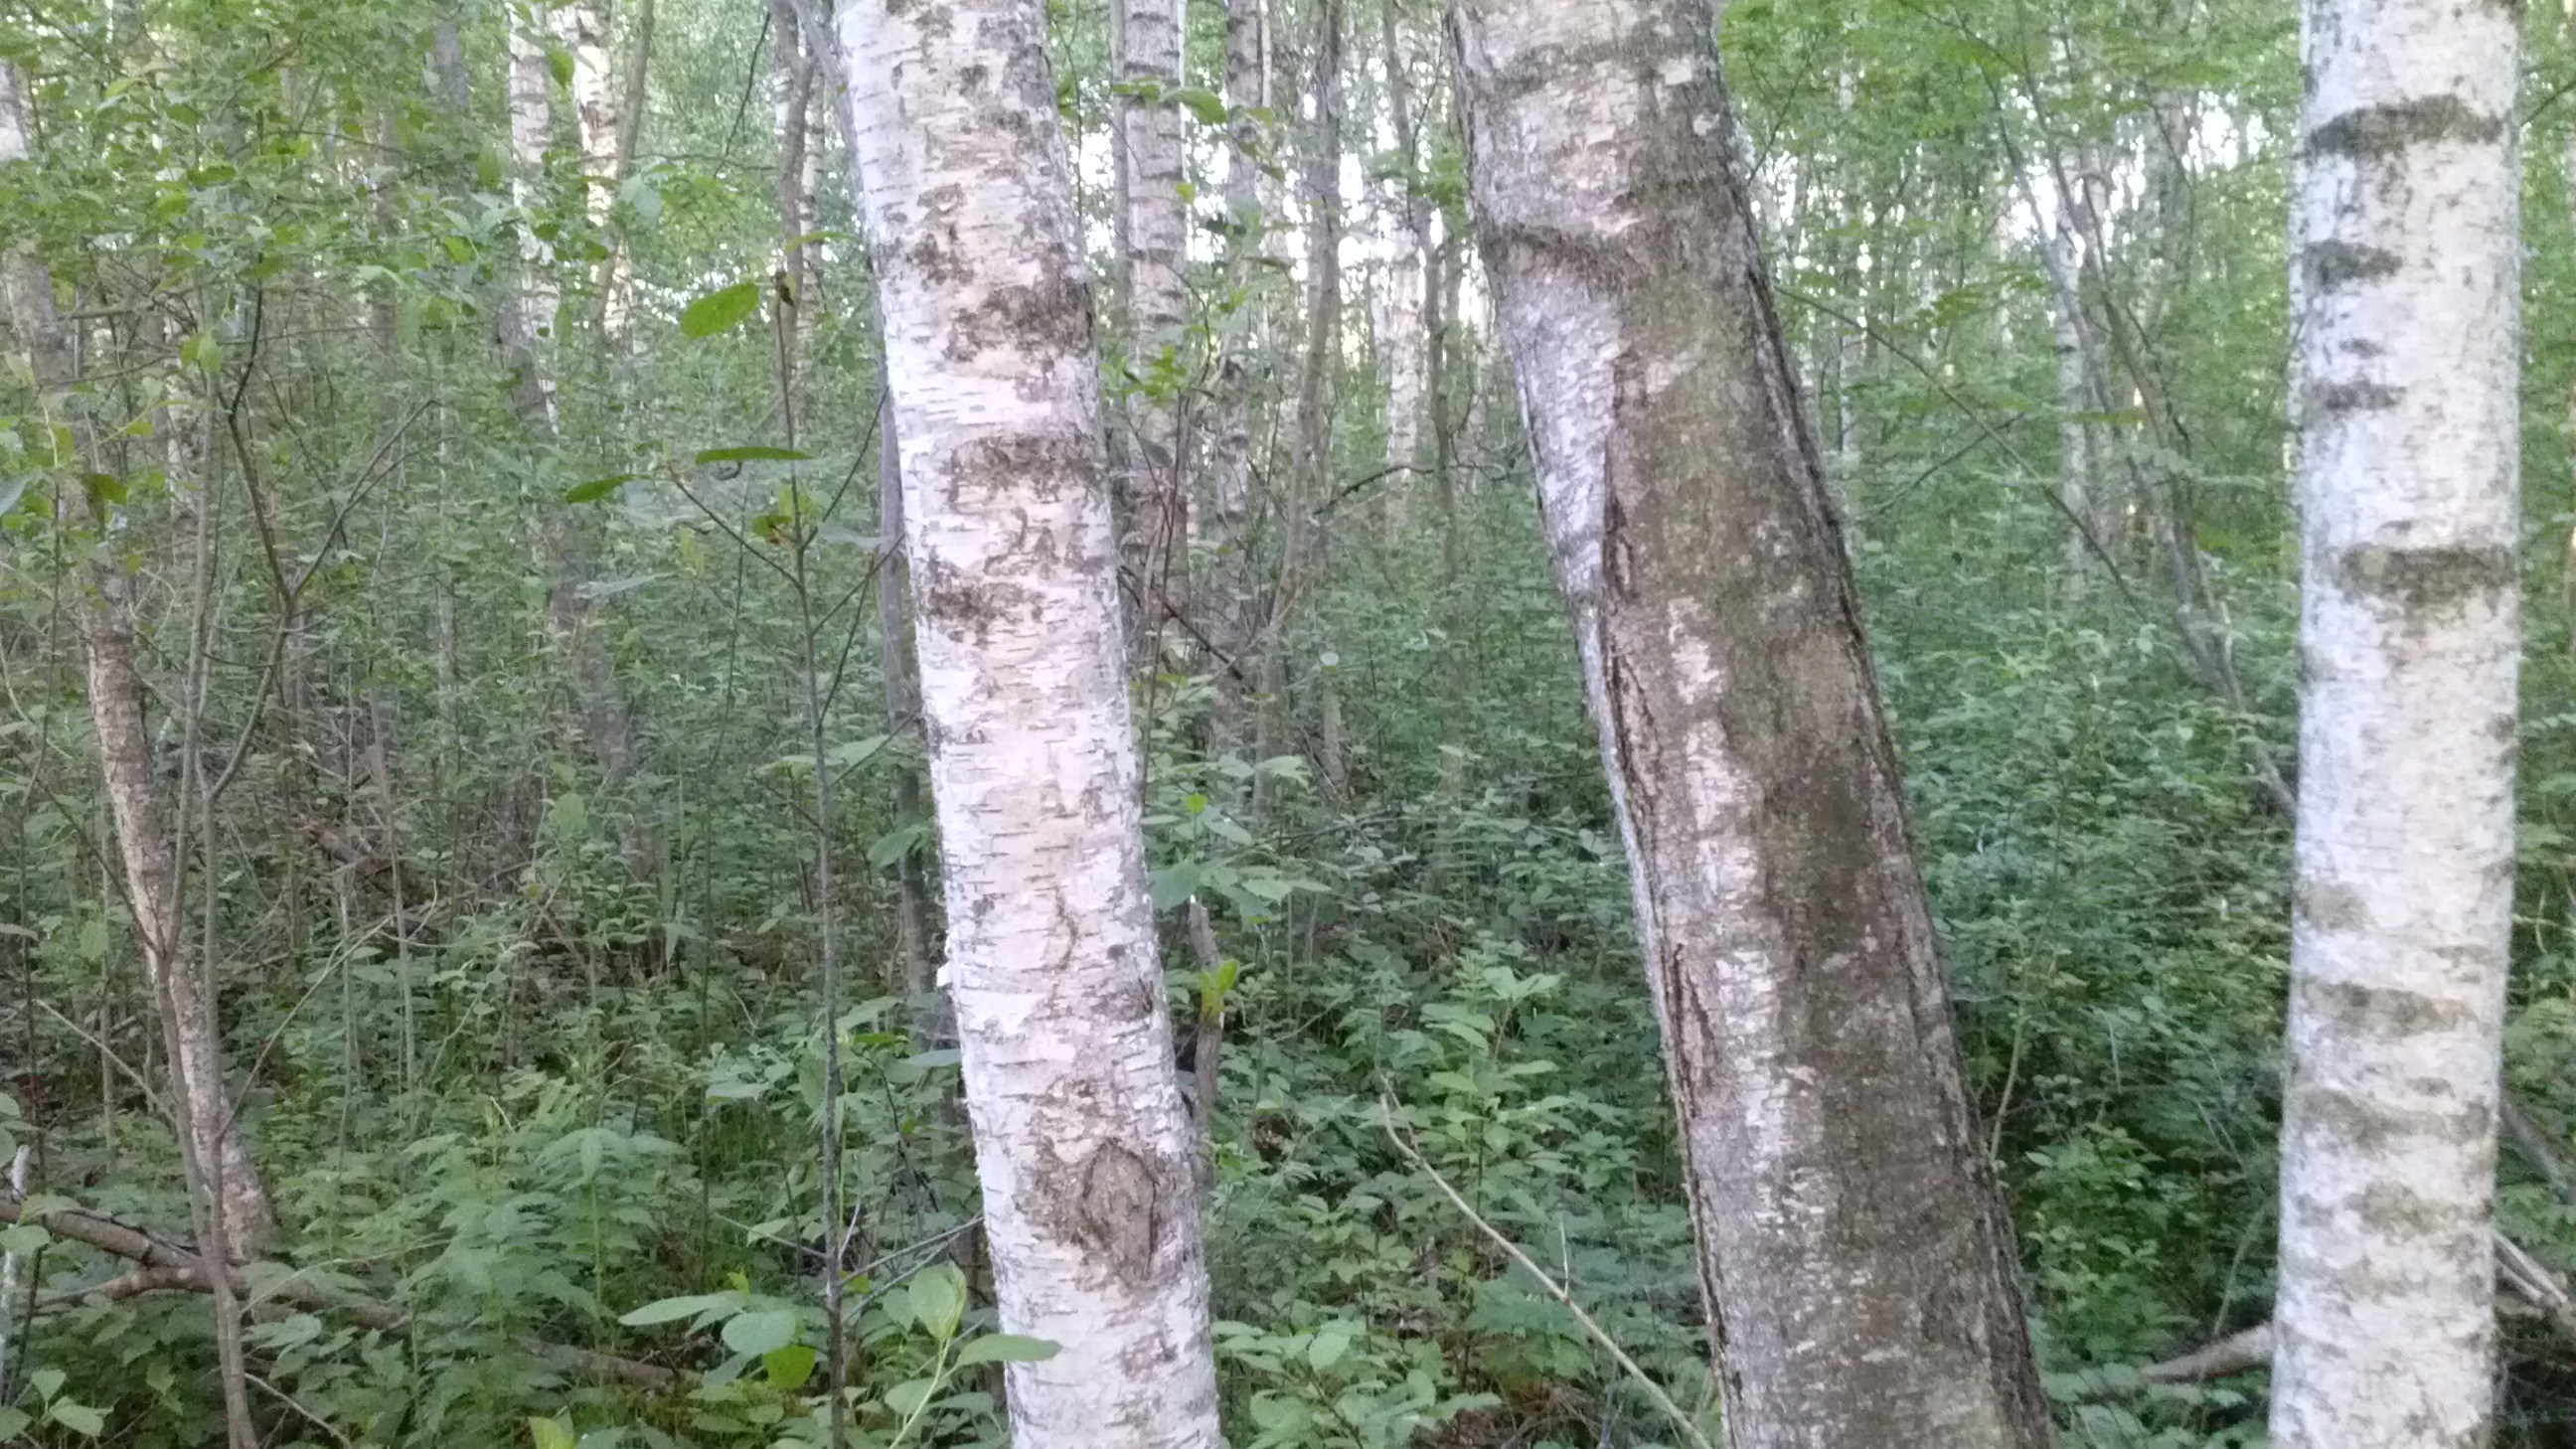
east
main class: Woodland
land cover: Broadleaved woodland
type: non-riverine alder, birch or aspen forest
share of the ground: > 75 %
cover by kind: broadleaved forest trees 95 %, herbaceous plants 5 %
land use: Forestry
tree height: > 5 m
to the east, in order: Broadleaved woodland; Grassland without tree/shrub cover; Tracks; Grassland without tree/shrub cover; Broadleaved woodland; Inland marshes
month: June
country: LV
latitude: 56.4088
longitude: 27.9073
